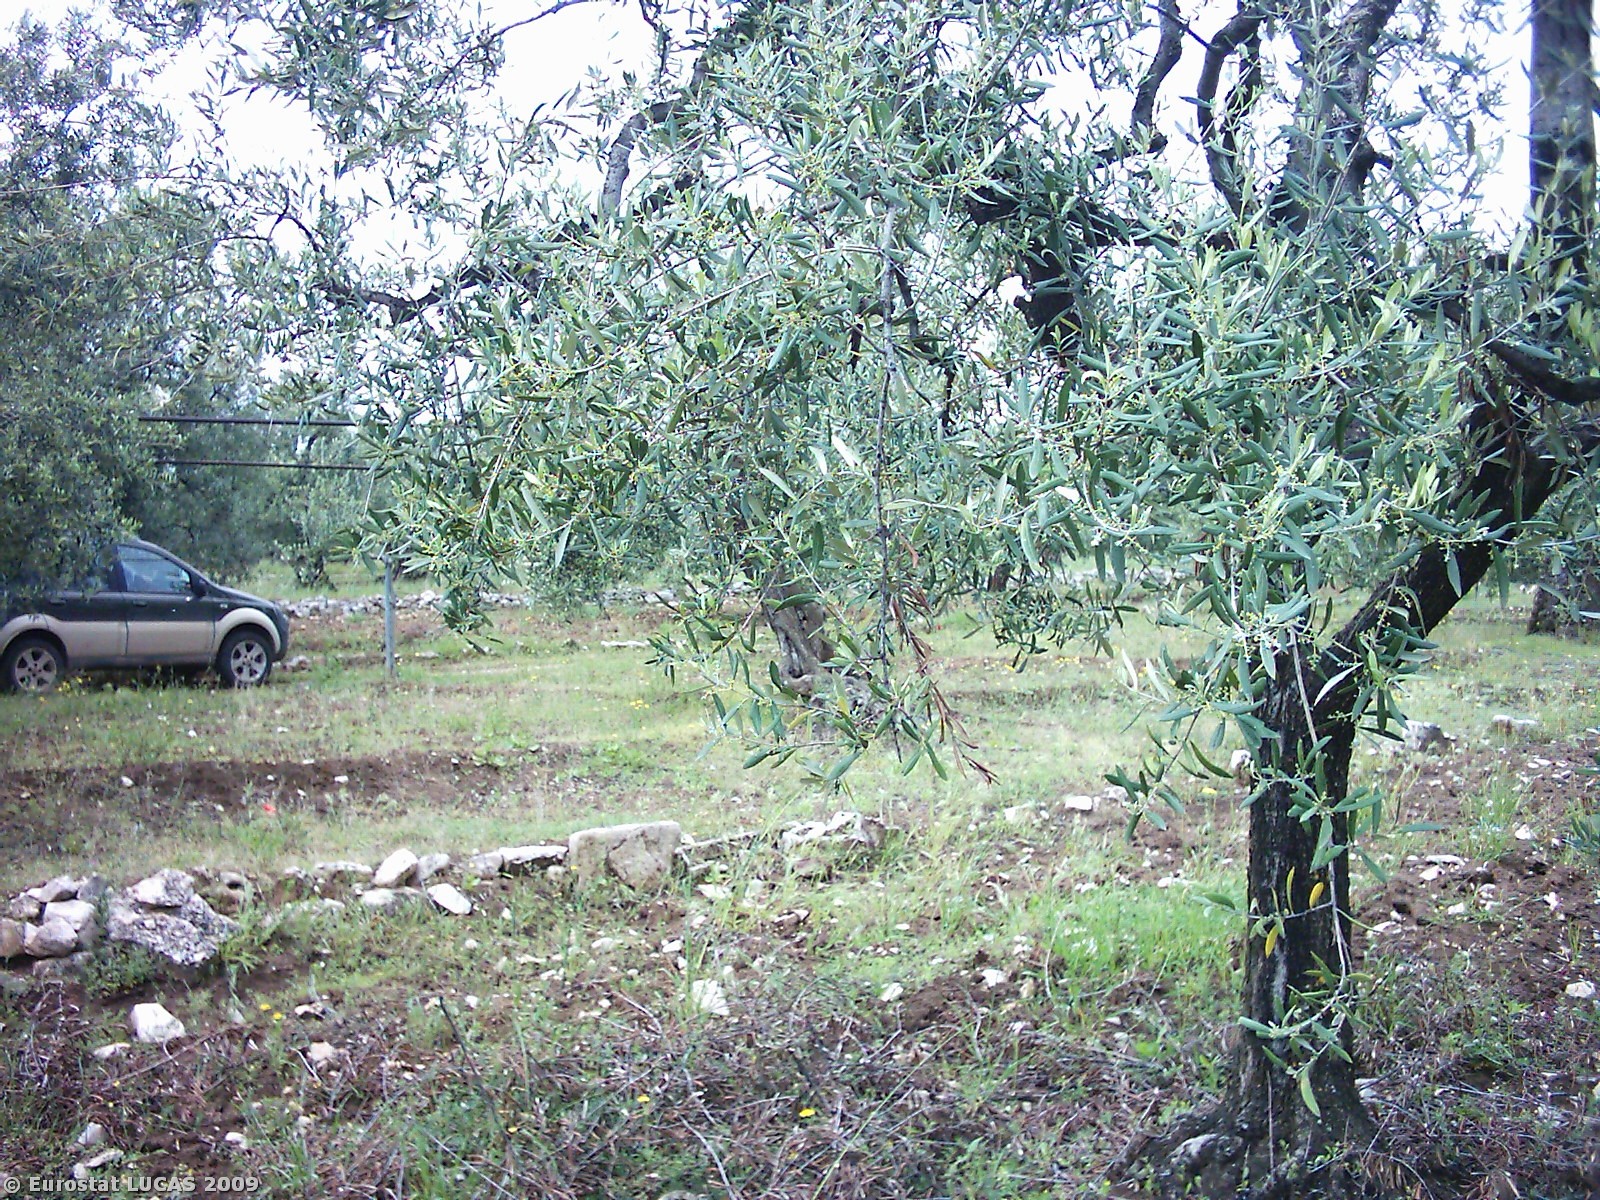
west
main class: Cropland
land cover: Olive groves
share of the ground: 25 - 50 %
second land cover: Bare land
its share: 50 - 75 %
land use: Agriculture (excluding fallow land and kitchen gardens)
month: April
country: IT
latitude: 41.2217
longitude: 16.3618
